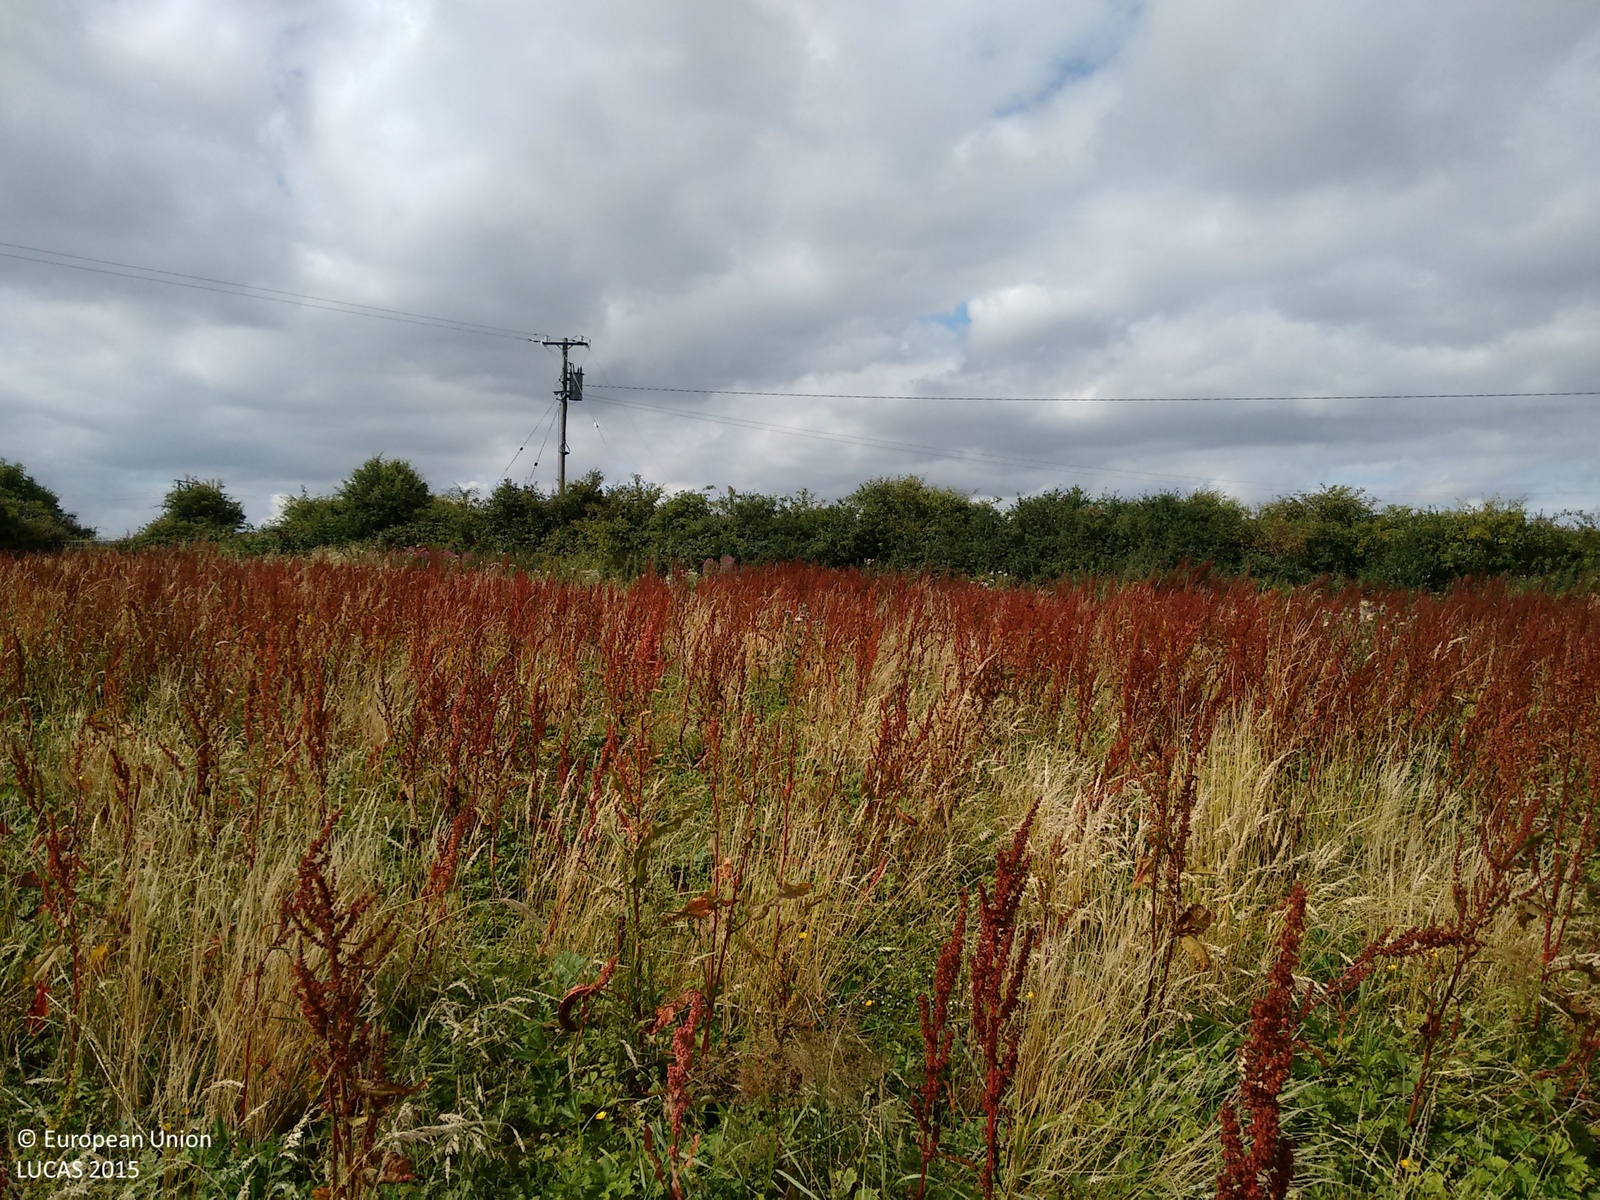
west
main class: Grassland
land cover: Spontaneously vegetated surfaces
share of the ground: > 75 %
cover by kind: herbaceous plants 95 %, shrubs 5 %
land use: Fallow land
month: August
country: IE
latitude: 53.8133
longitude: -6.4201
